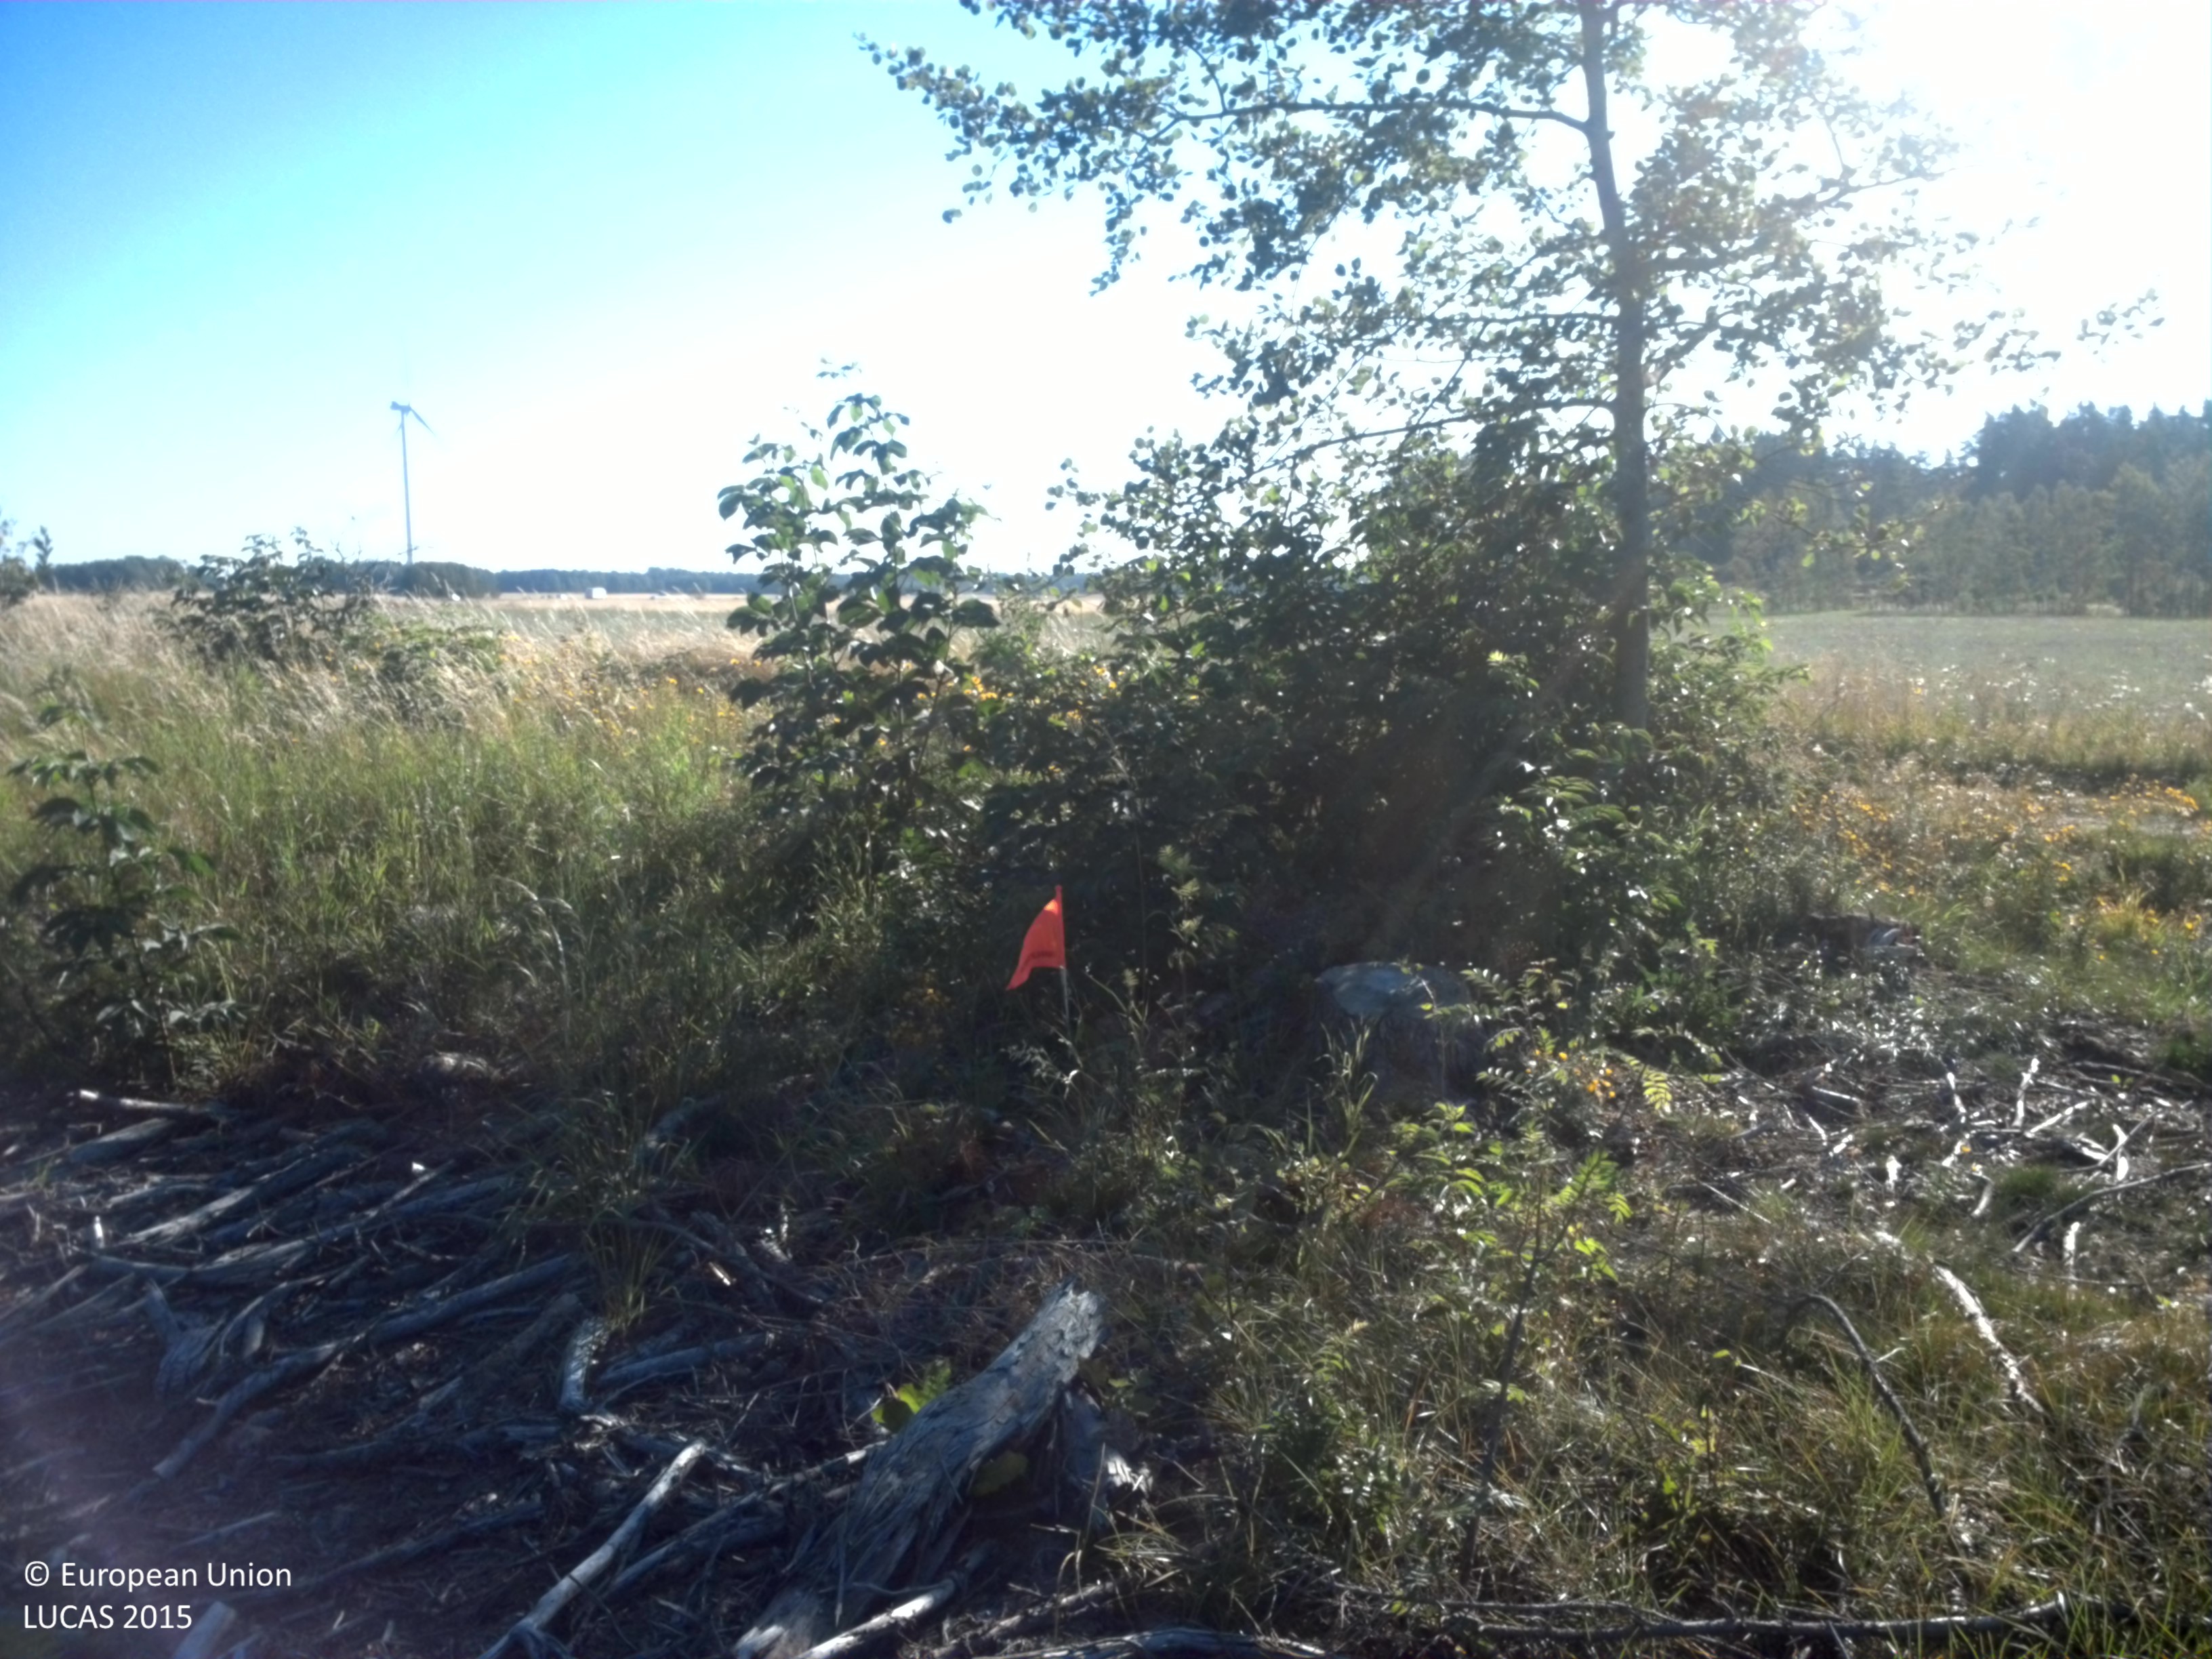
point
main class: Woodland
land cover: Broadleaved woodland
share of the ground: < 10 %
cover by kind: consolidated bare surface 85 %, broadleaved forest trees 10 %, herbaceous plants 5 %
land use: Forestry
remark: Clear cut
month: August
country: SE
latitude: 58.3429
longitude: 13.2231
